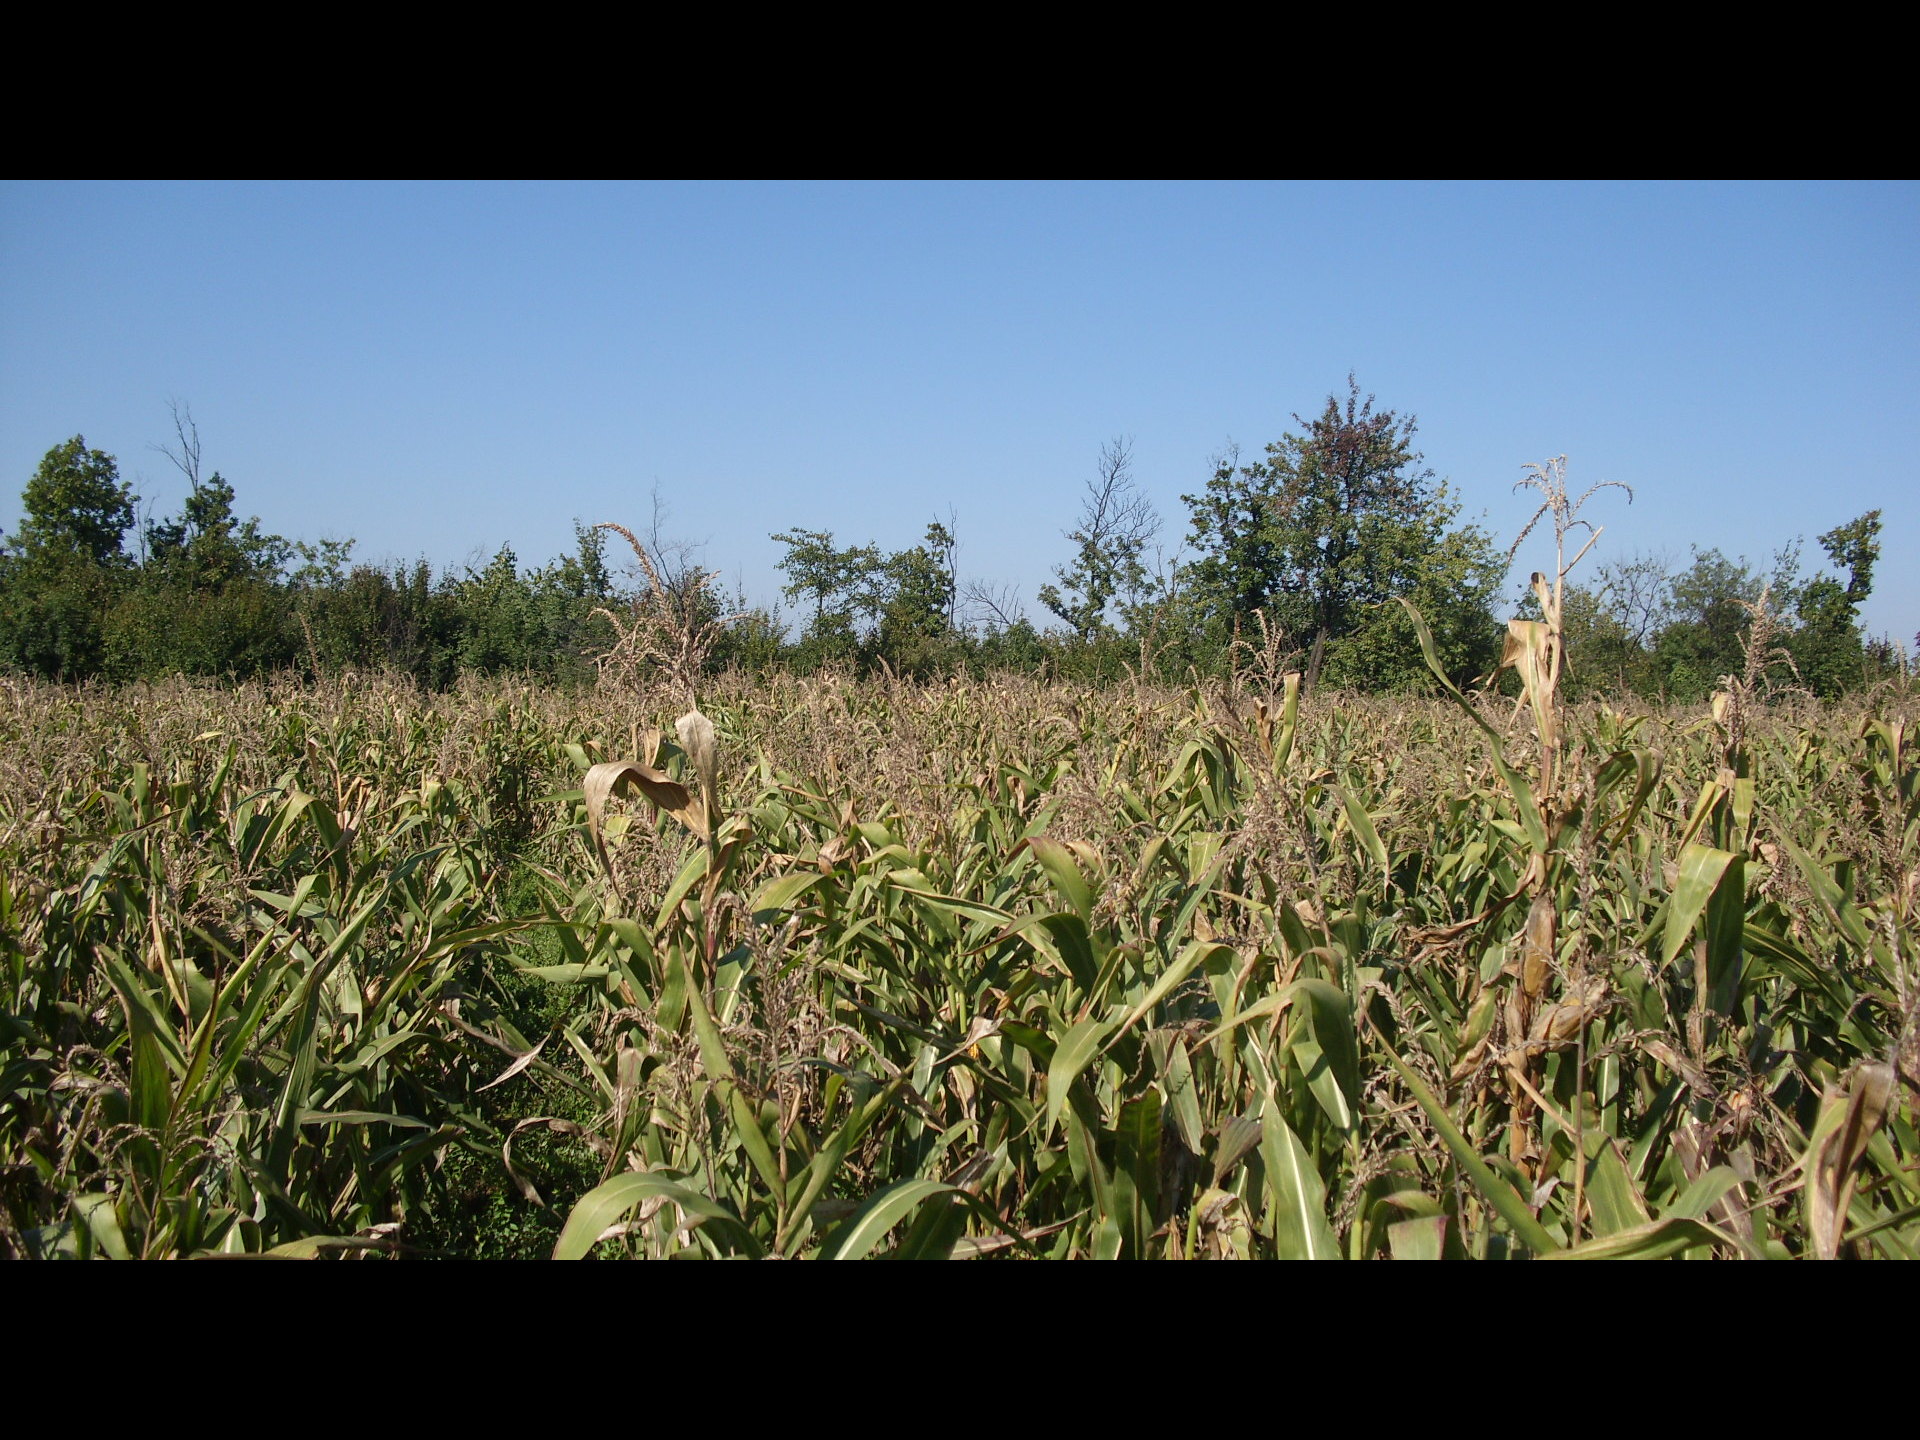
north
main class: Cropland
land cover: Maize
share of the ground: > 75 %
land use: Agriculture (excluding fallow land and kitchen gardens)
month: October
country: BG
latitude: 43.9101
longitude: 22.7255
